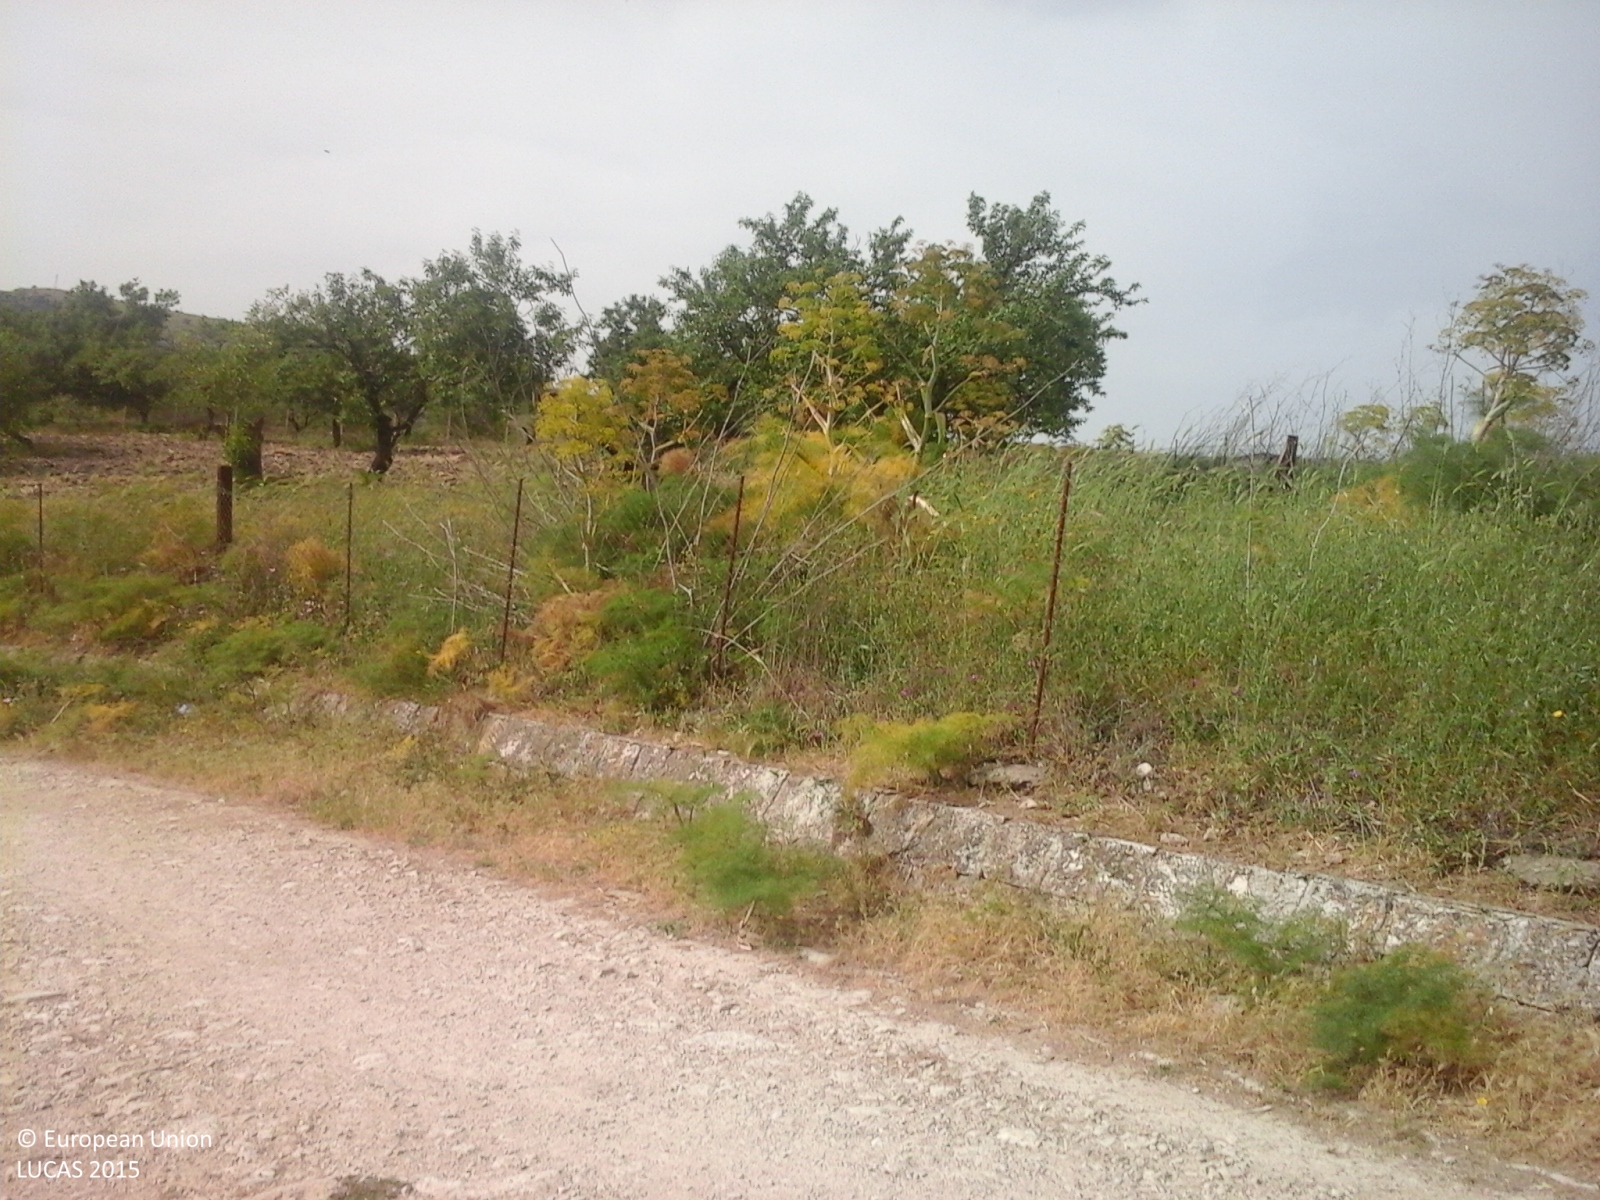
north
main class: Cropland
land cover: Olive groves
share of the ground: > 75 %
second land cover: Grassland without tree/shrub cover
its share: > 75 %
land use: Agriculture (excluding fallow land and kitchen gardens)
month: May
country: IT
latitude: 37.5757
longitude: 13.9226
